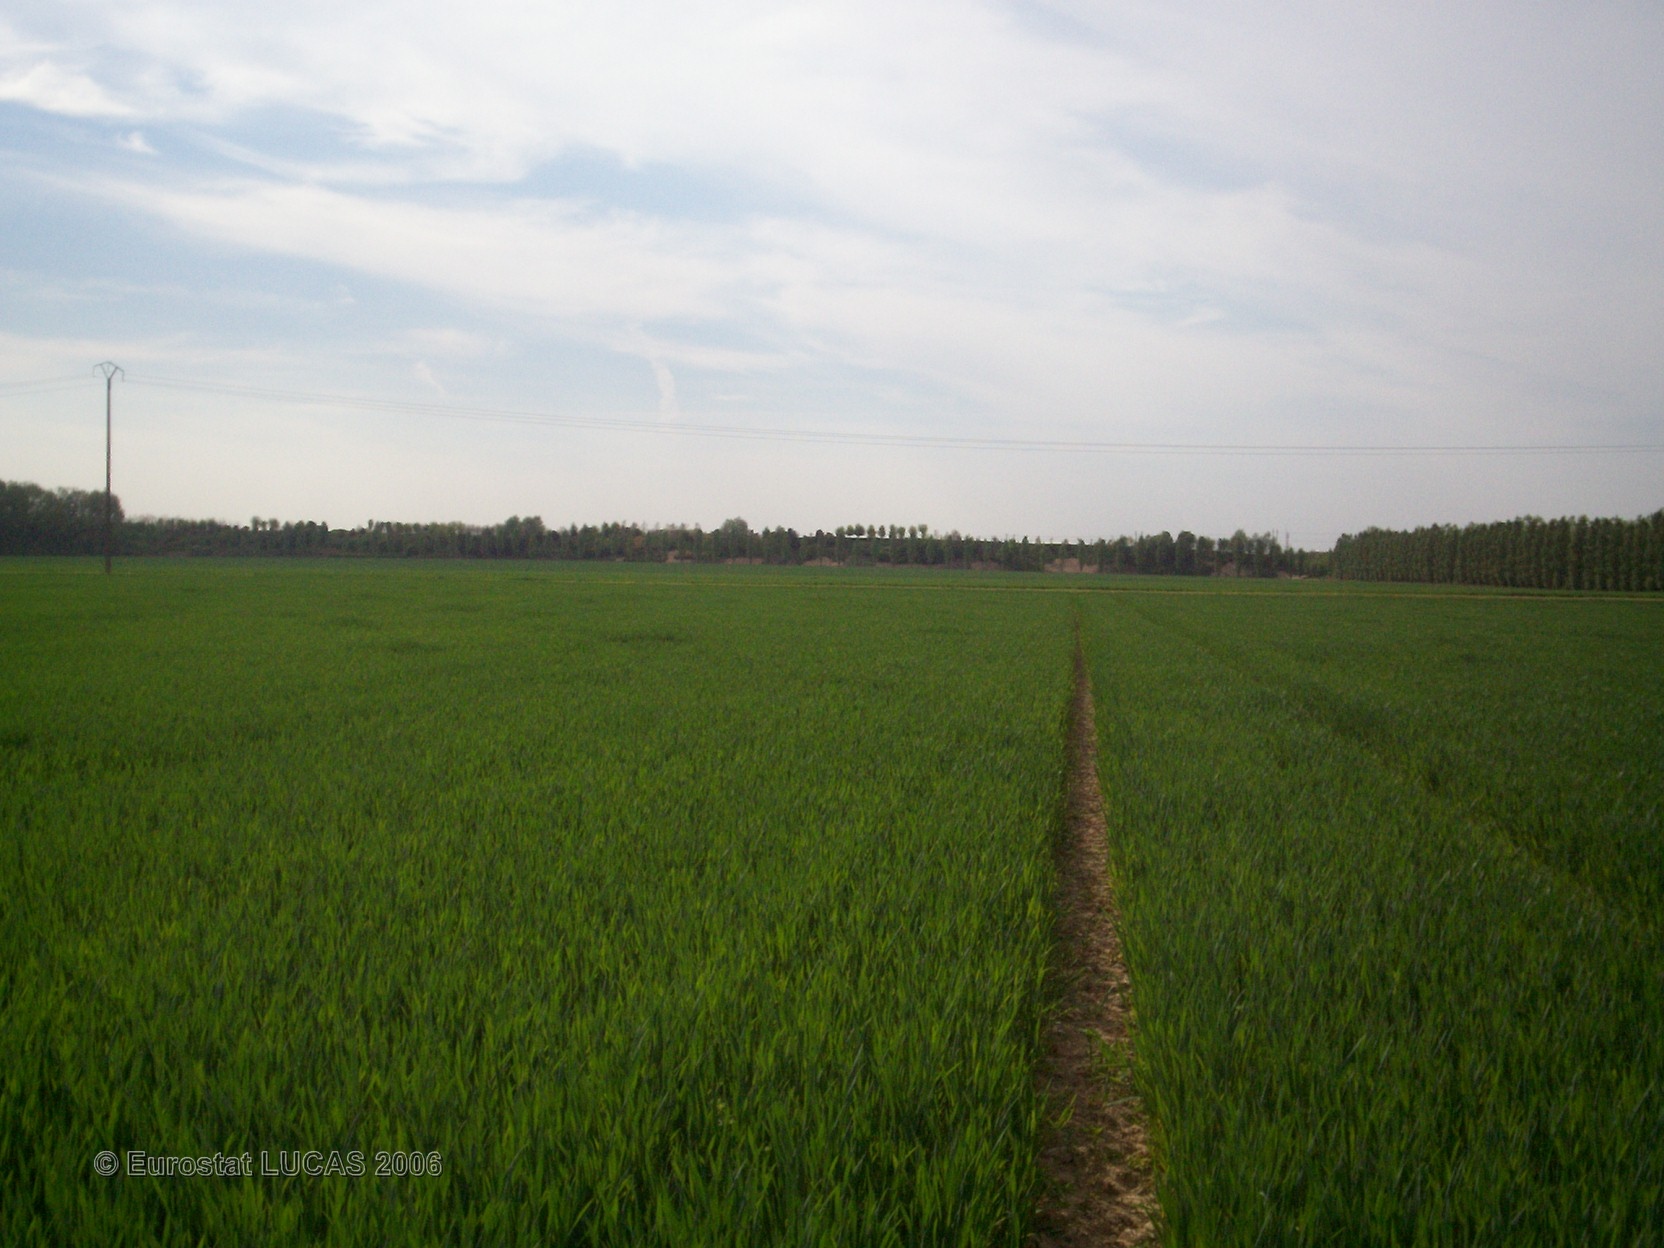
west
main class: Cropland
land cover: Common wheat
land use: Agriculture (excluding fallow land and kitchen gardens)
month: May
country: FR
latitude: 48.7285
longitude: 2.7988
